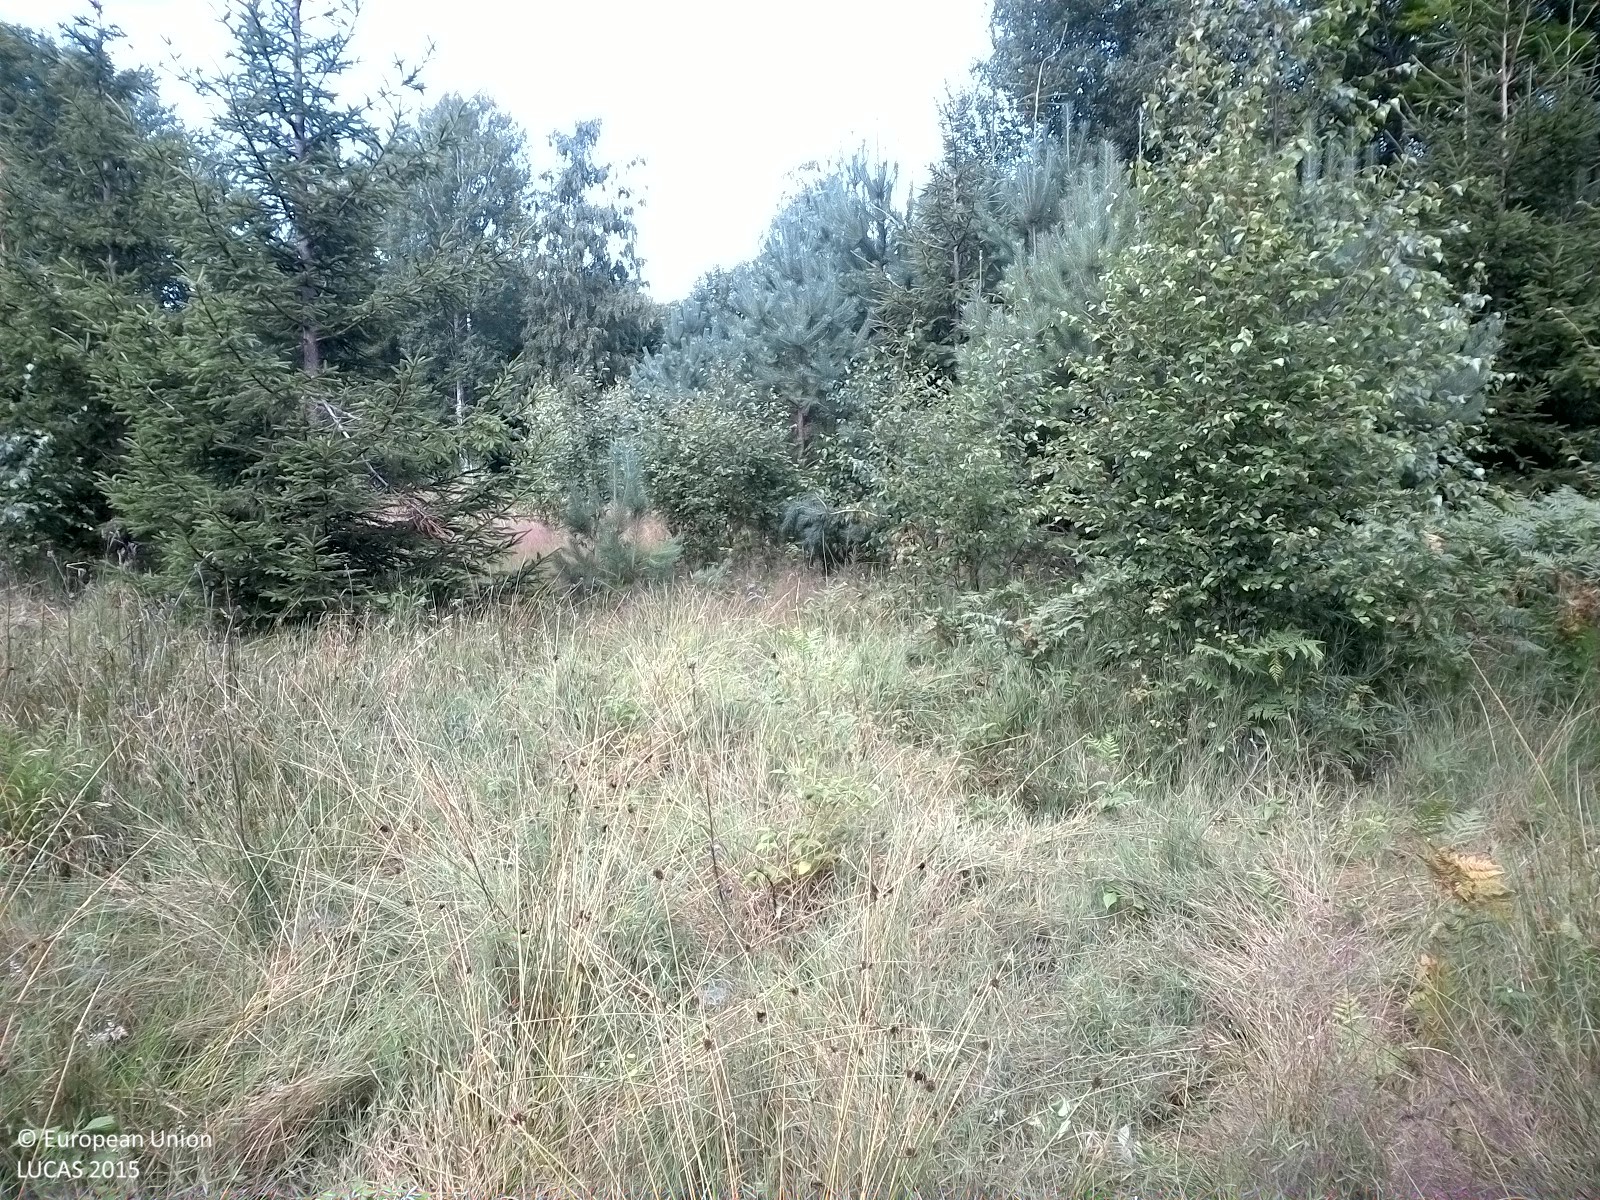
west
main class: Woodland
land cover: Other mixed woodland
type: hemiboreal forest and nemoral coniferous forest and mixed broadleaved-coniferous forest
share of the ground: 25 - 50 %
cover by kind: herbaceous plants 70 %, coniferous forest trees 15 %, broadleaved forest trees 15 %
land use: Forestry
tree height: < 5 m
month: August
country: SE
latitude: 58.8883
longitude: 15.3544
